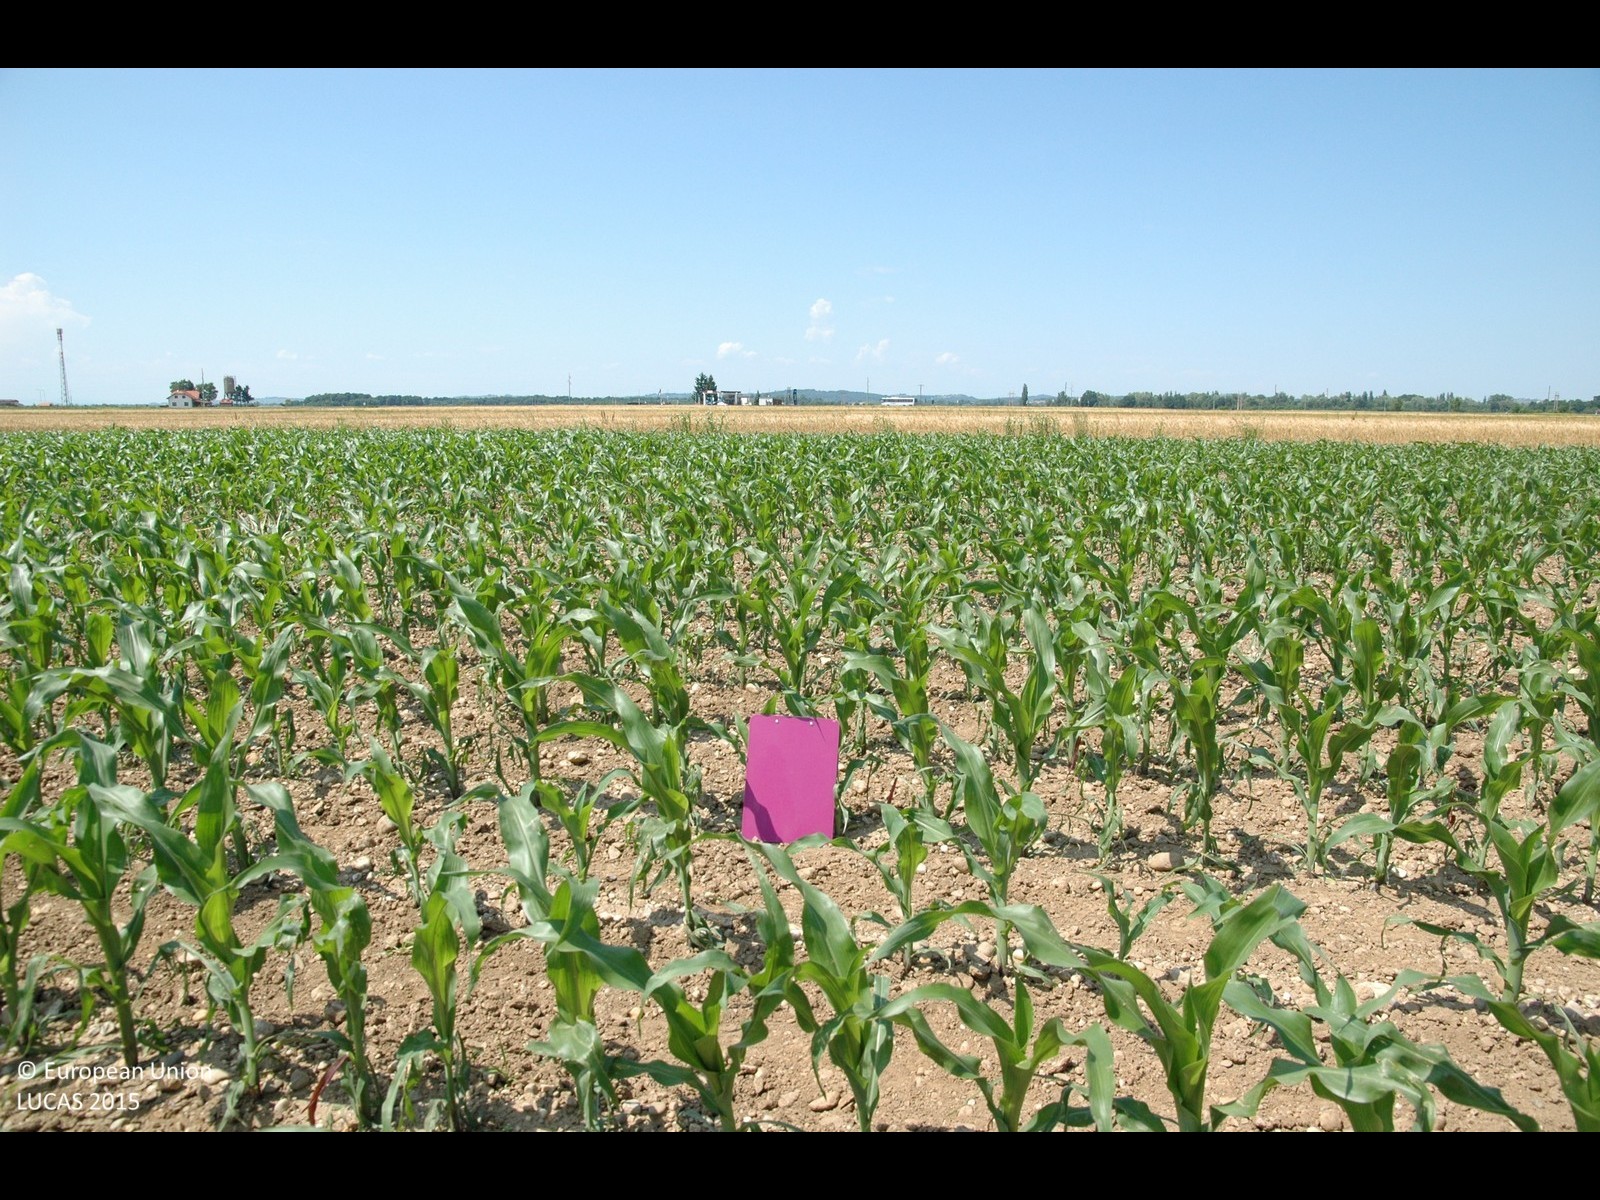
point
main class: Cropland
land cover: Maize
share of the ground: 25 - 50 %
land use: Agriculture (excluding fallow land and kitchen gardens)
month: June
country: HR
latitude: 46.3535
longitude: 16.1726
